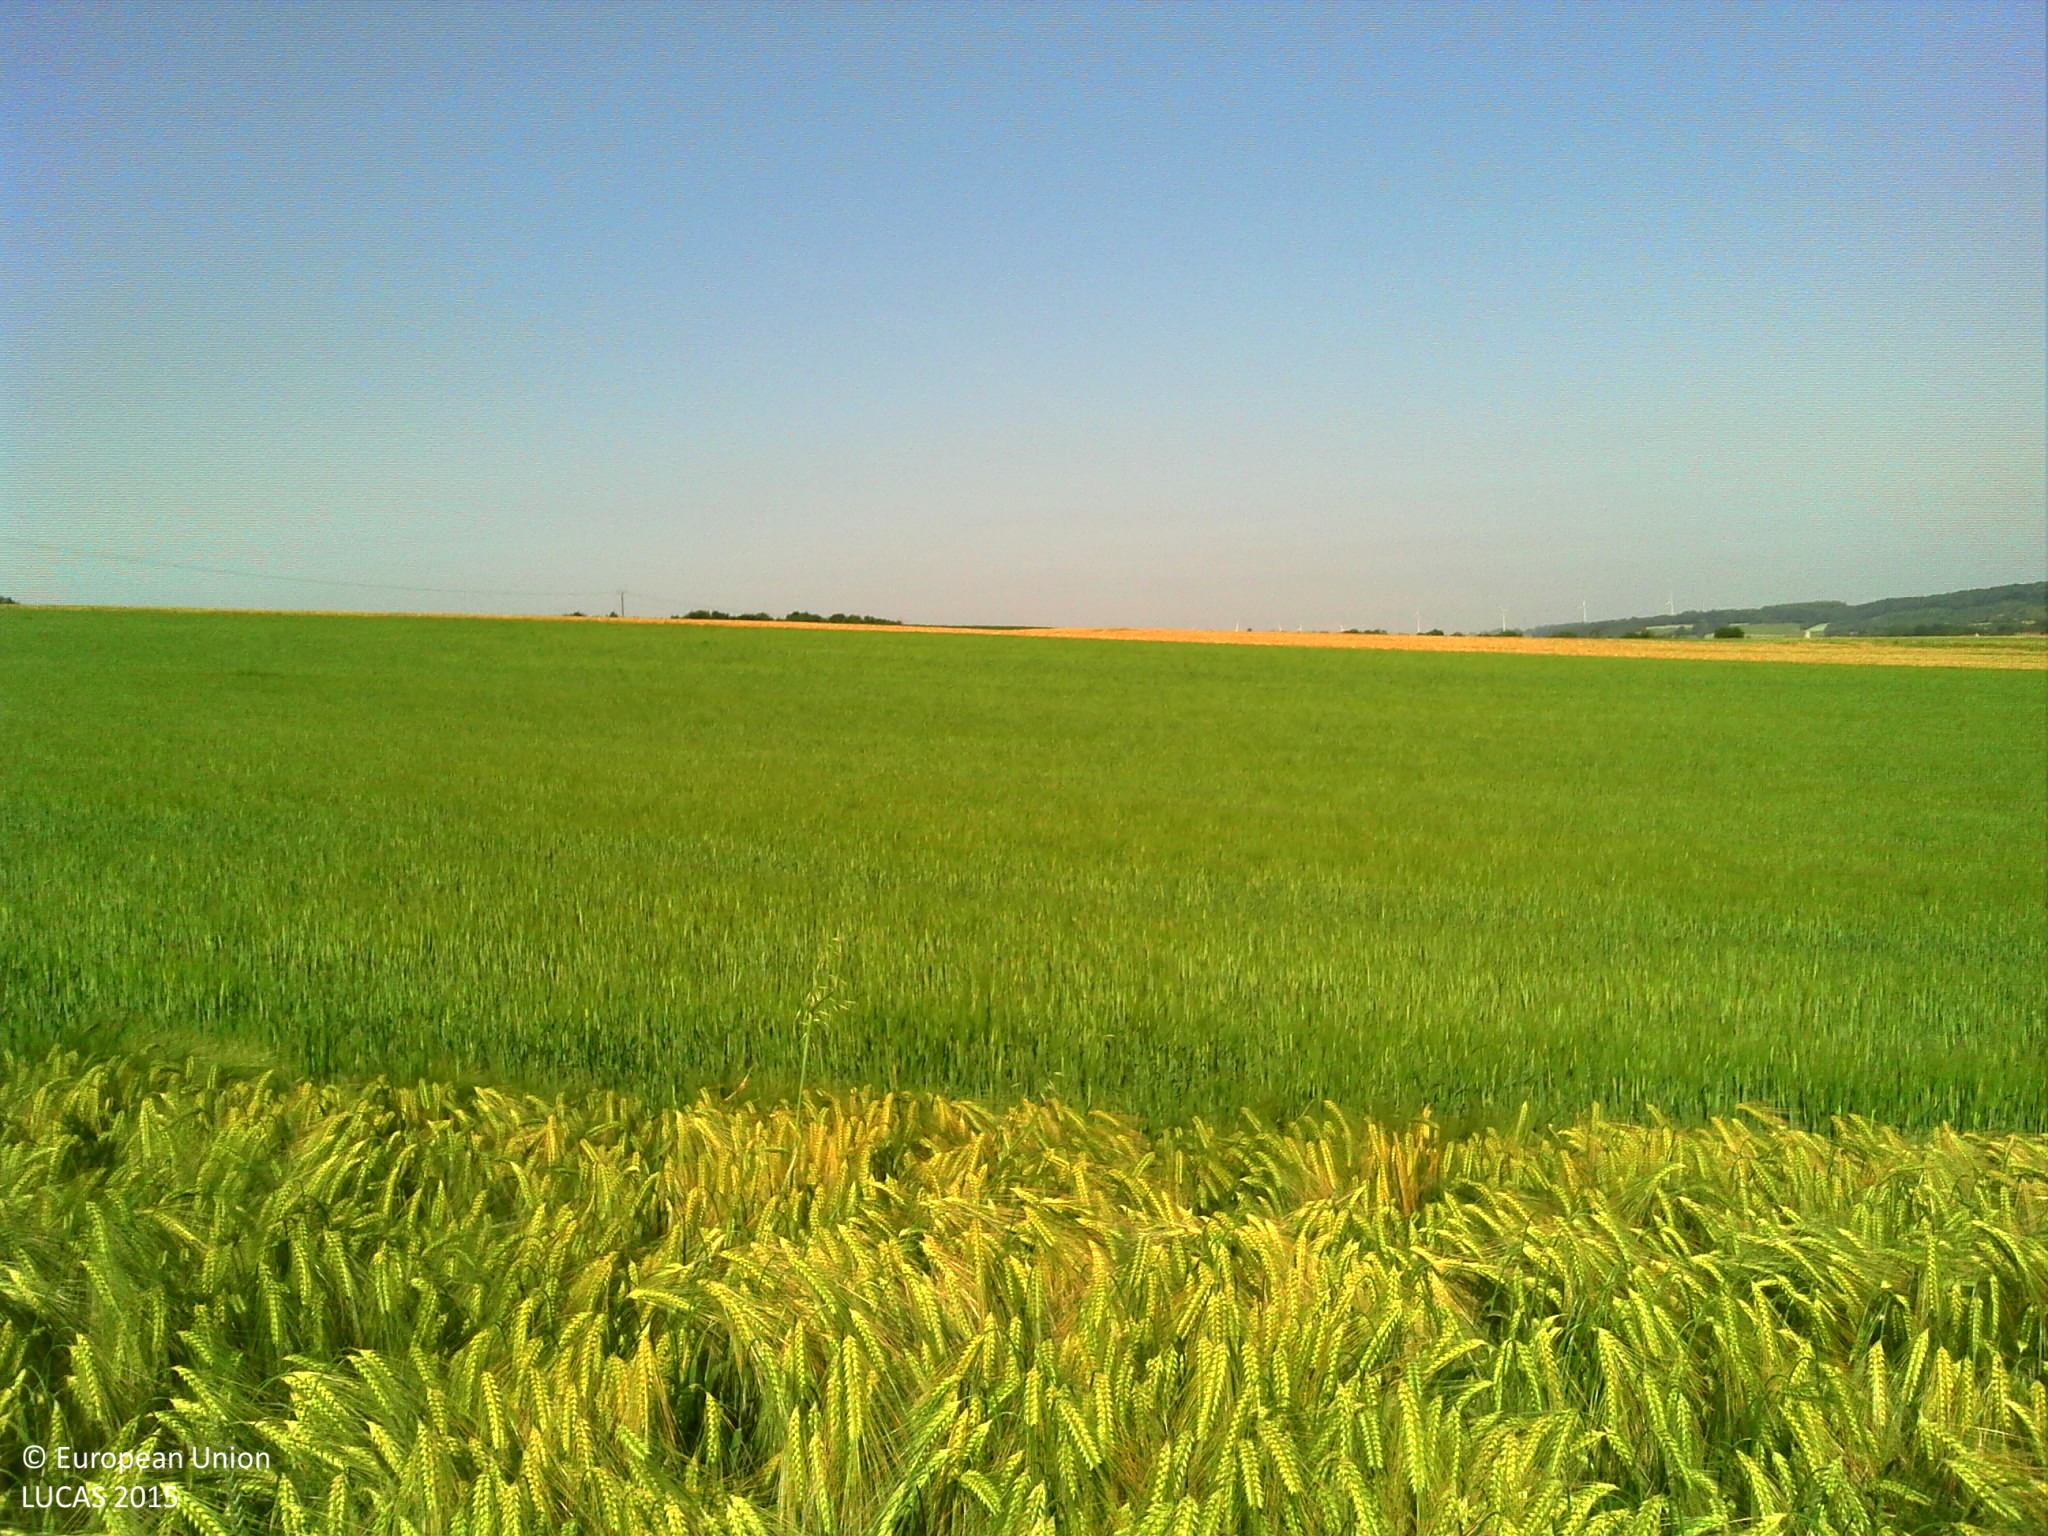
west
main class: Cropland
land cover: Barley
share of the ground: > 75 %
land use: Agriculture (excluding fallow land and kitchen gardens)
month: June
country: FR
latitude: 50.4755
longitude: 2.4484
